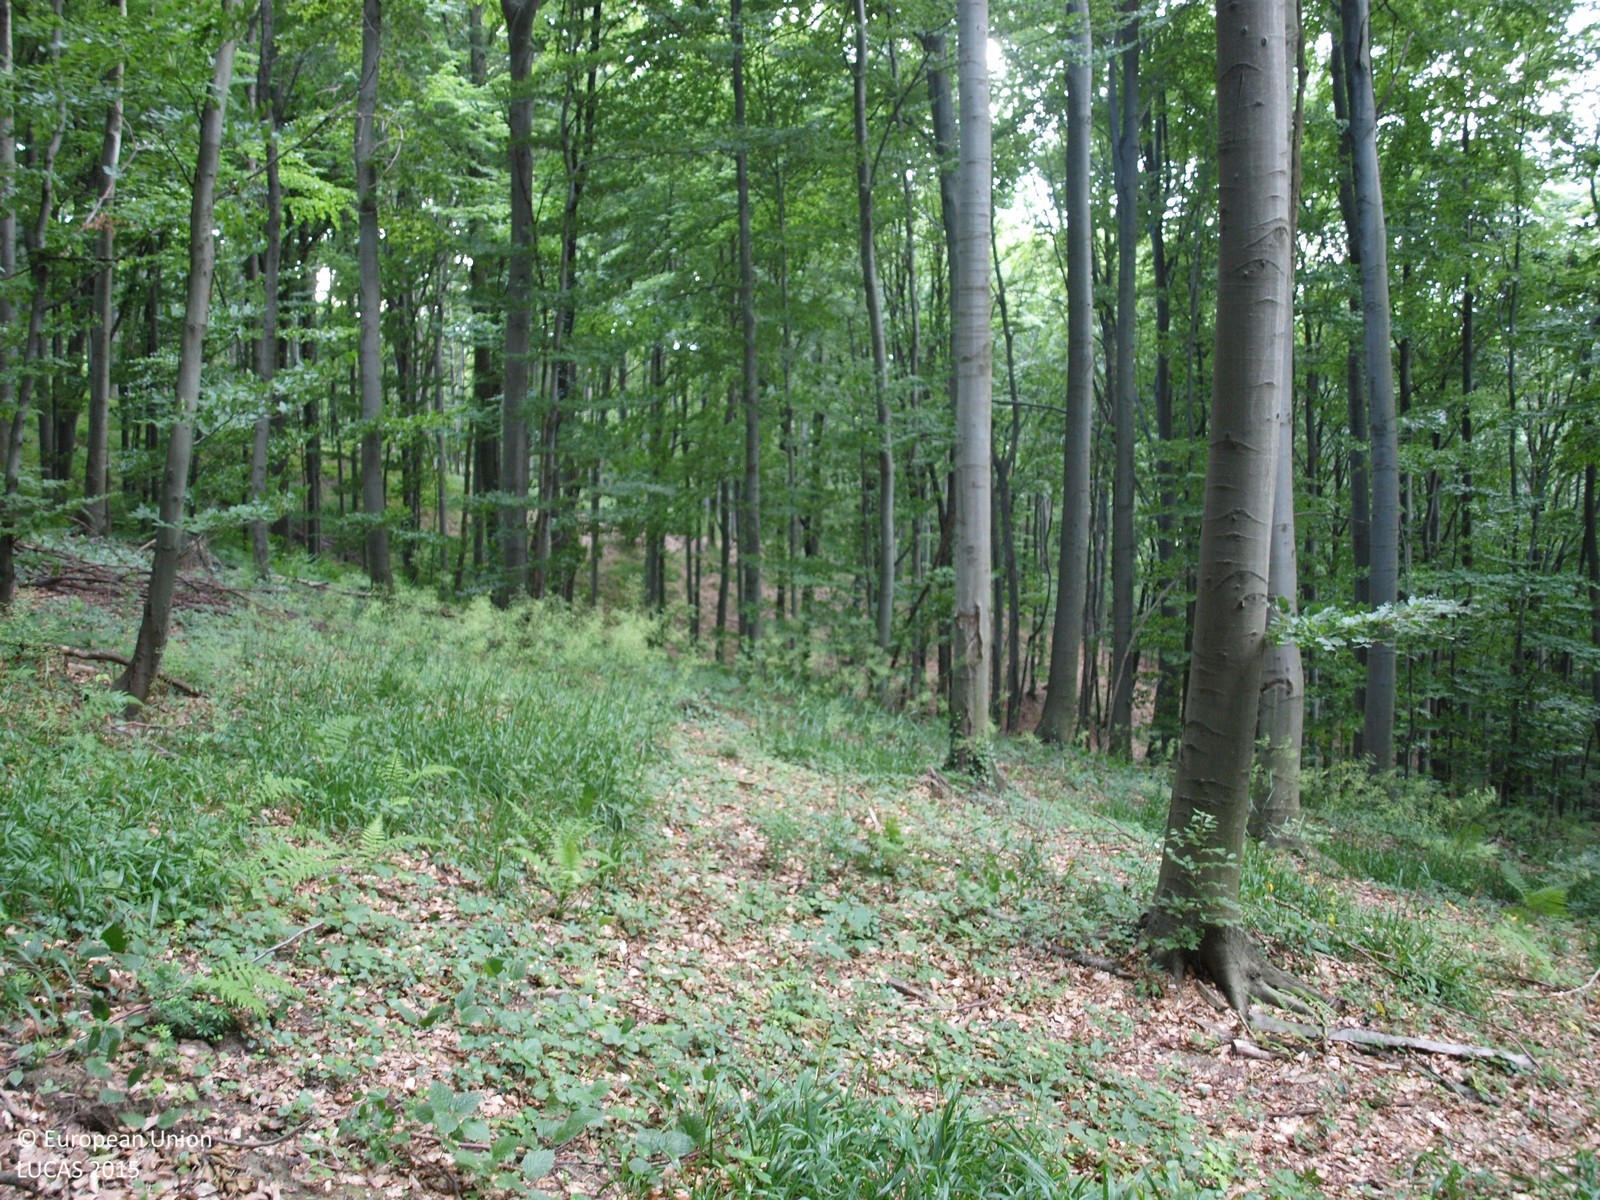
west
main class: Woodland
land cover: Broadleaved woodland
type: beech forest
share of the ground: > 75 %
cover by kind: broadleaved forest trees 100 %
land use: Forestry
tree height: > 5 m
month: June
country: HR
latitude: 46.1737
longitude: 16.4637
